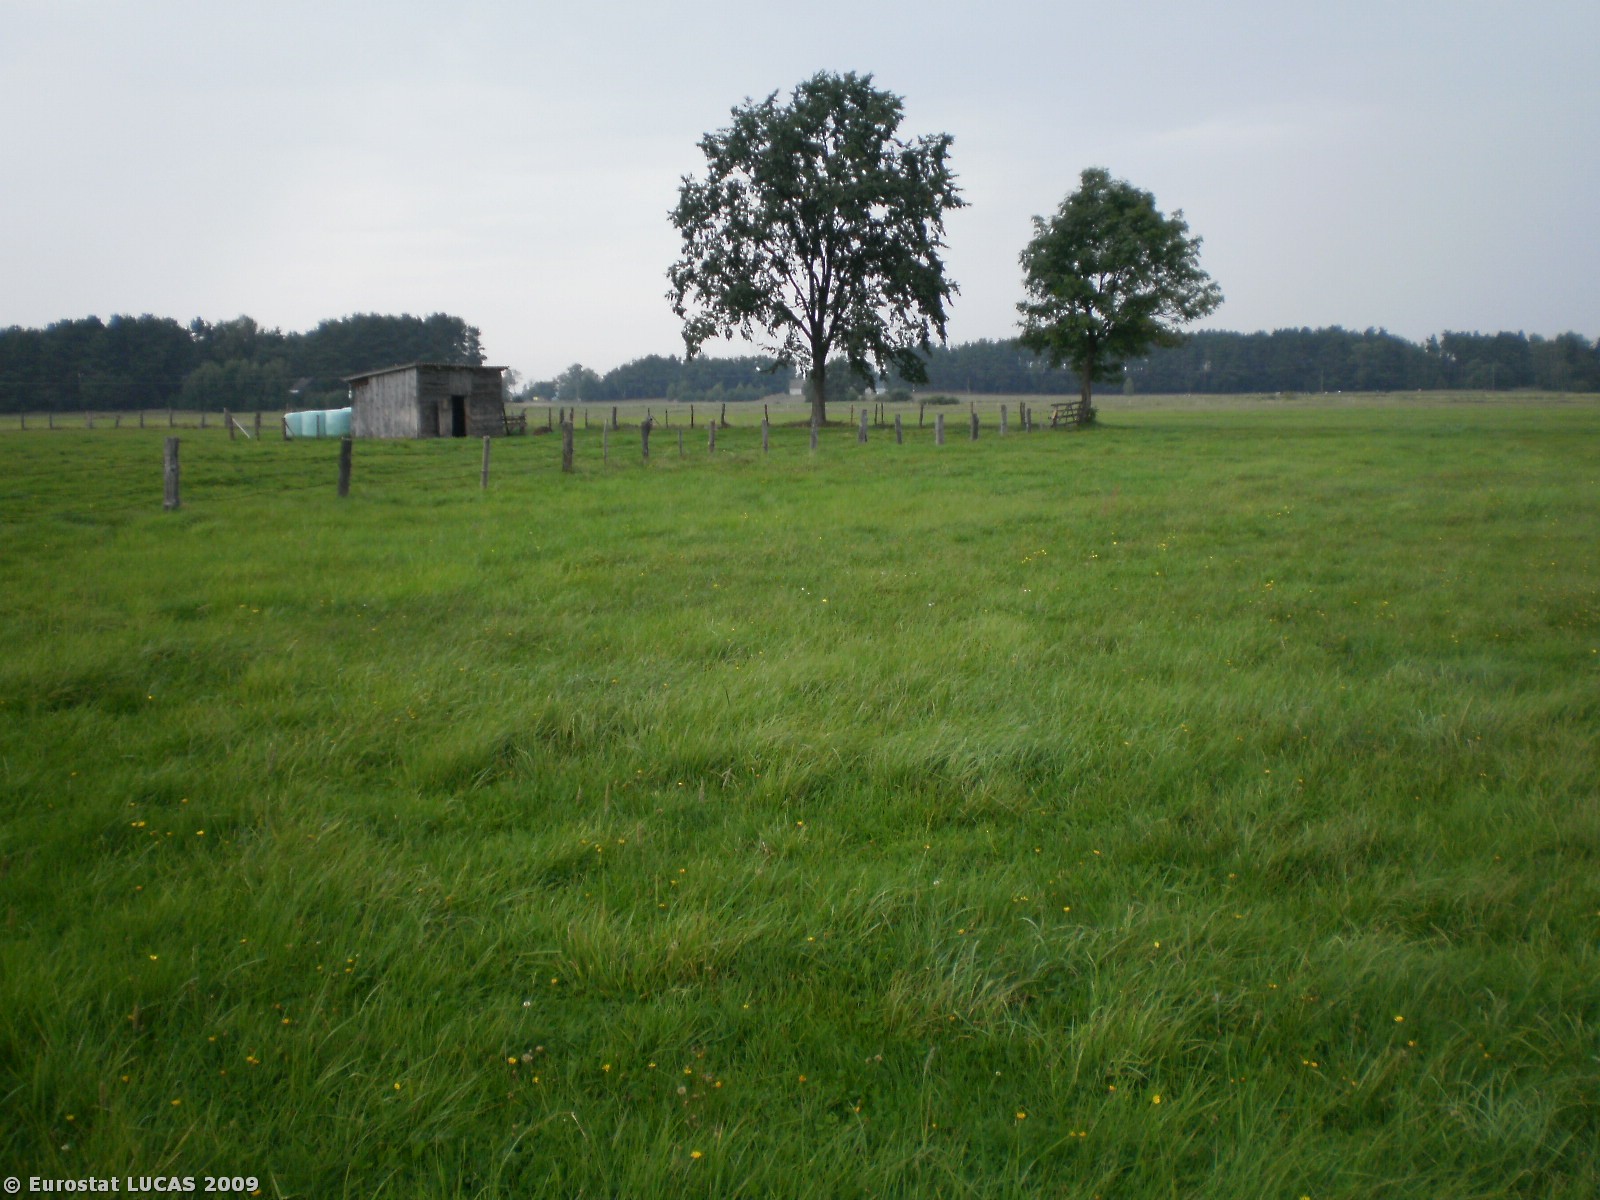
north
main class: Grassland
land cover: Grassland without tree/shrub cover
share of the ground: > 75 %
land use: Agriculture (excluding fallow land and kitchen gardens)
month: August
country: PL
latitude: 53.3564
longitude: 21.5448
